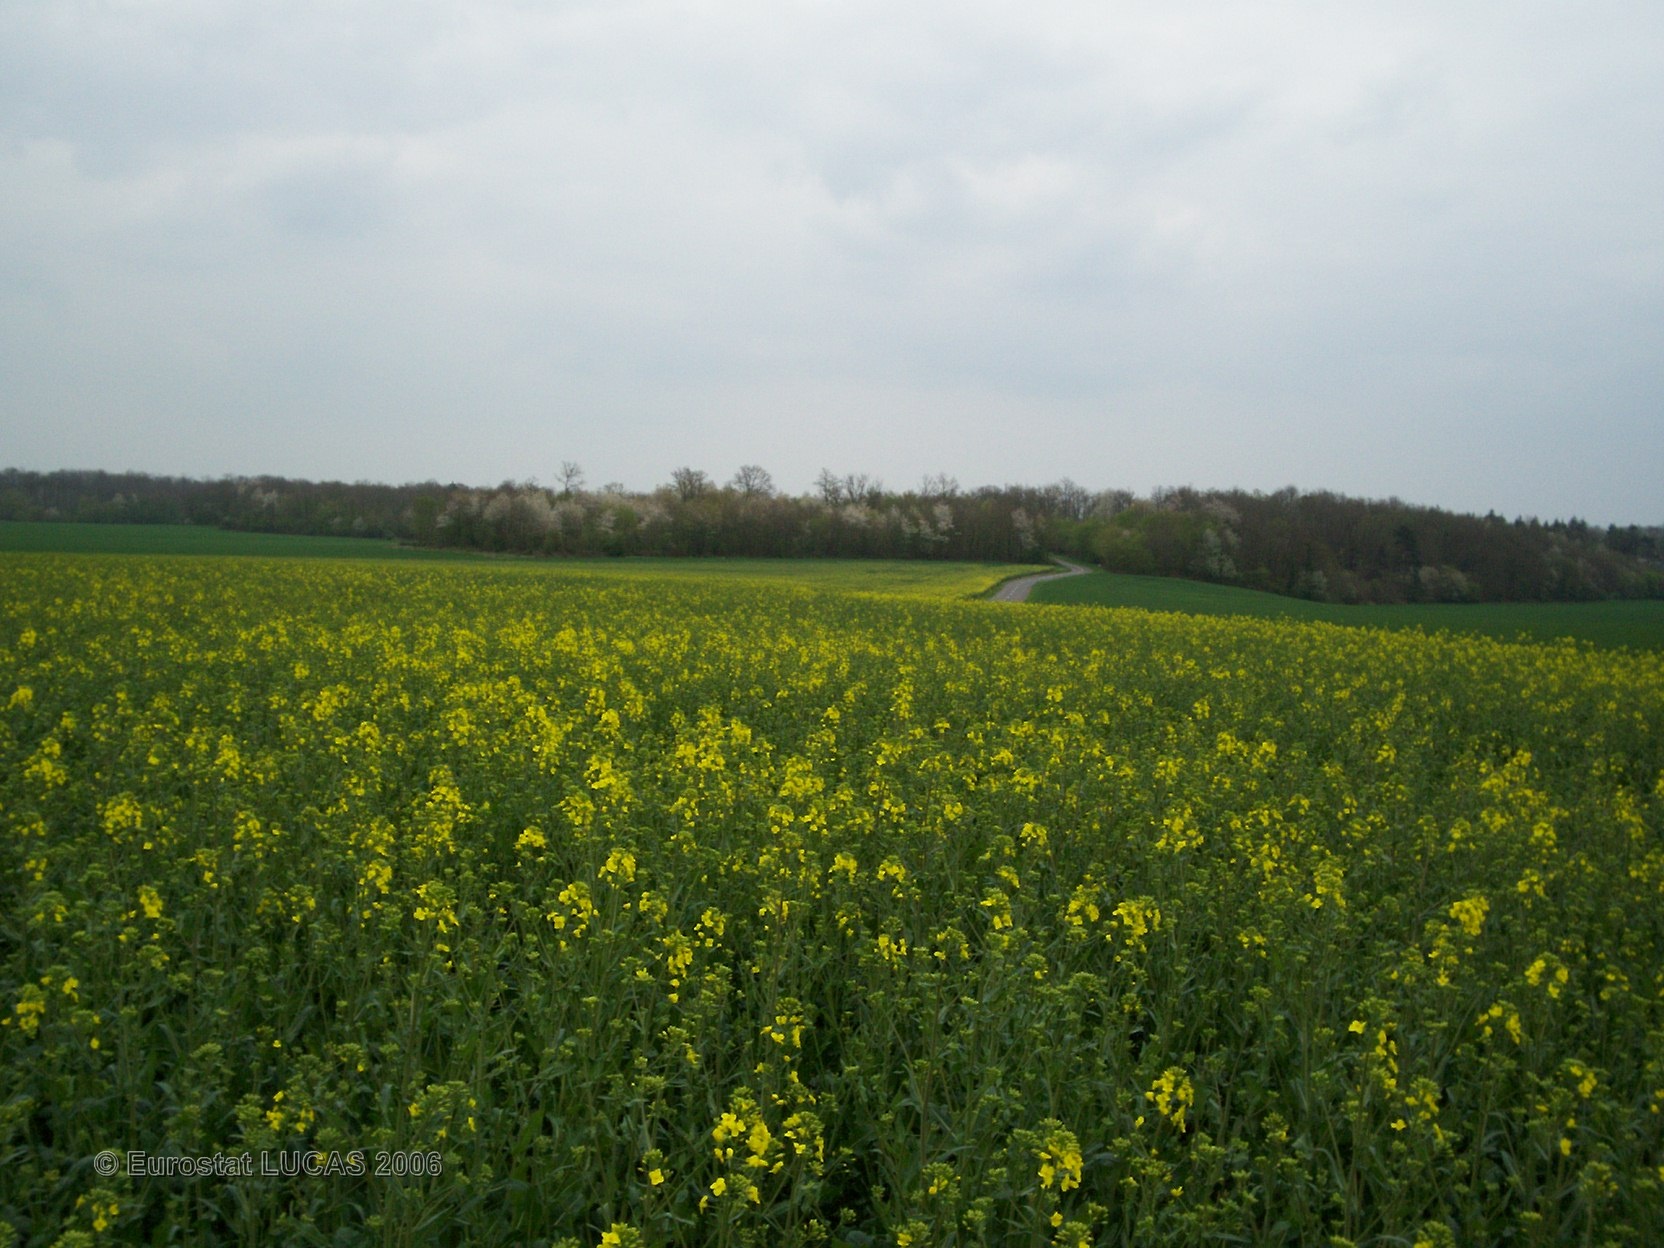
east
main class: Cropland
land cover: Rape and turnip rape
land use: Agriculture (excluding fallow land and kitchen gardens)
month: April
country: FR
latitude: 48.8725
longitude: 1.0487
